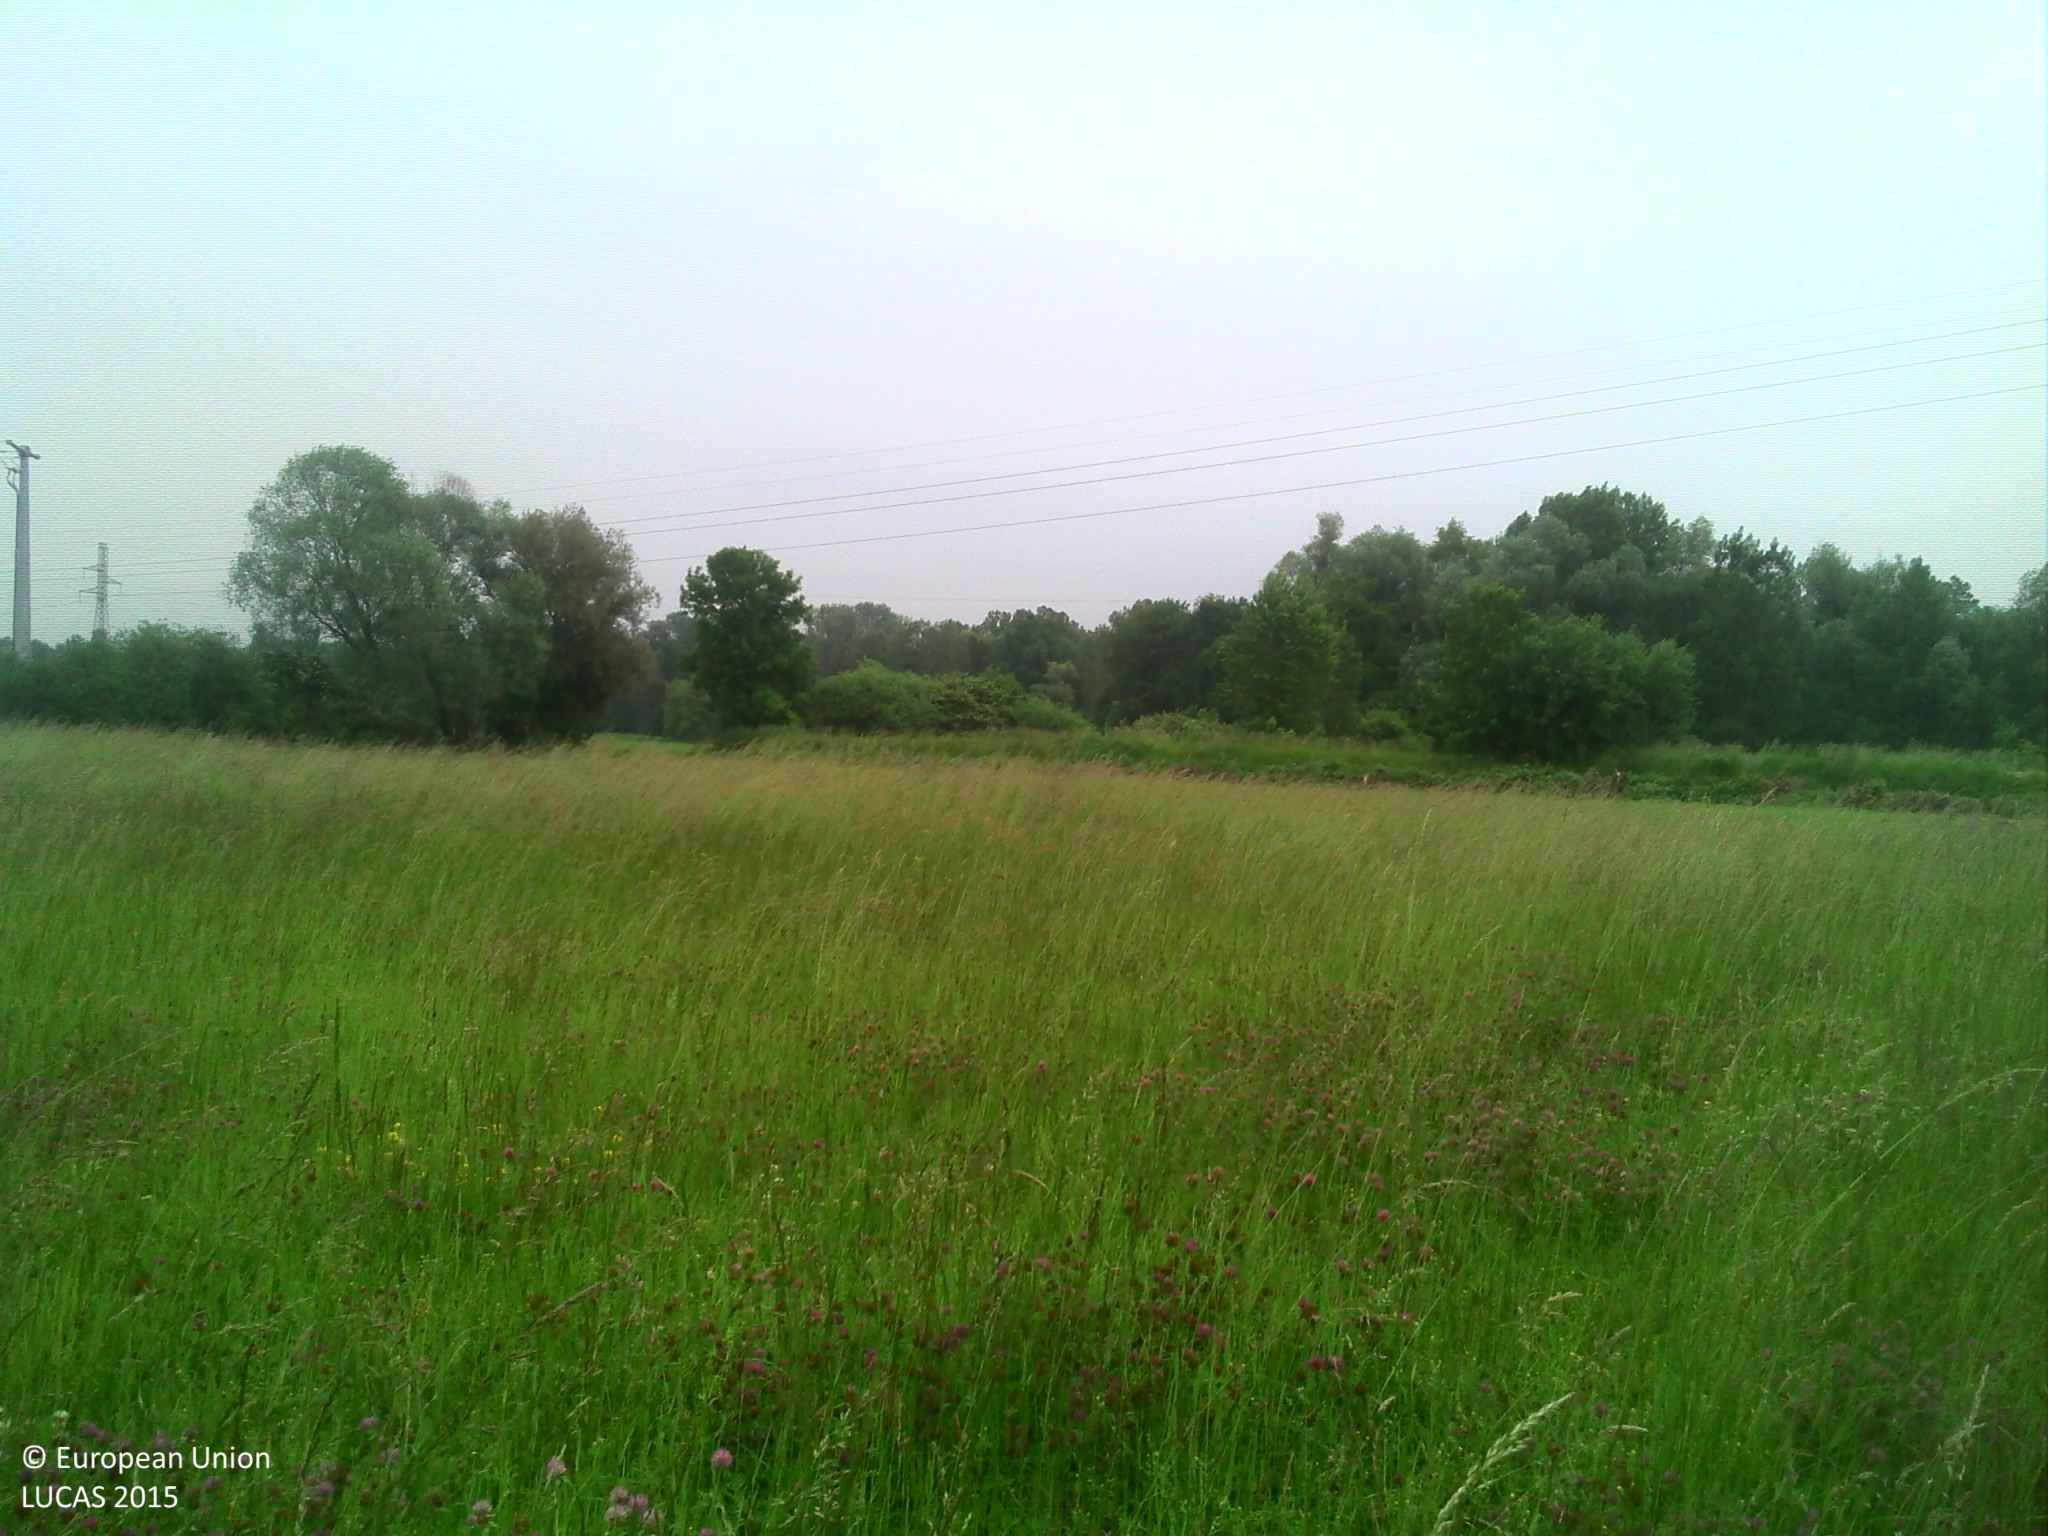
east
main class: Grassland
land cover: Grassland without tree/shrub cover
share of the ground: > 75 %
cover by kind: herbaceous plants 100 %
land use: Agriculture (excluding fallow land and kitchen gardens)
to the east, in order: Grassland without tree/shrub cover; Maize; Abandoned hedges; Grass margins; Tracks; Grass margins; Electric lines; Single bushes/trees; Shrubland with sparse tree cover; Artificial constructions in urban areas; Shrubland with sparse tree cover; Broadleaved woodland; Maize; Electric lines; Maize; Broadleaved woodland; Ditches and canals; Grass margins; Paved roads, cycling and walking lanes; Grass margins
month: May
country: FR
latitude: 48.2889
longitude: 7.6693
